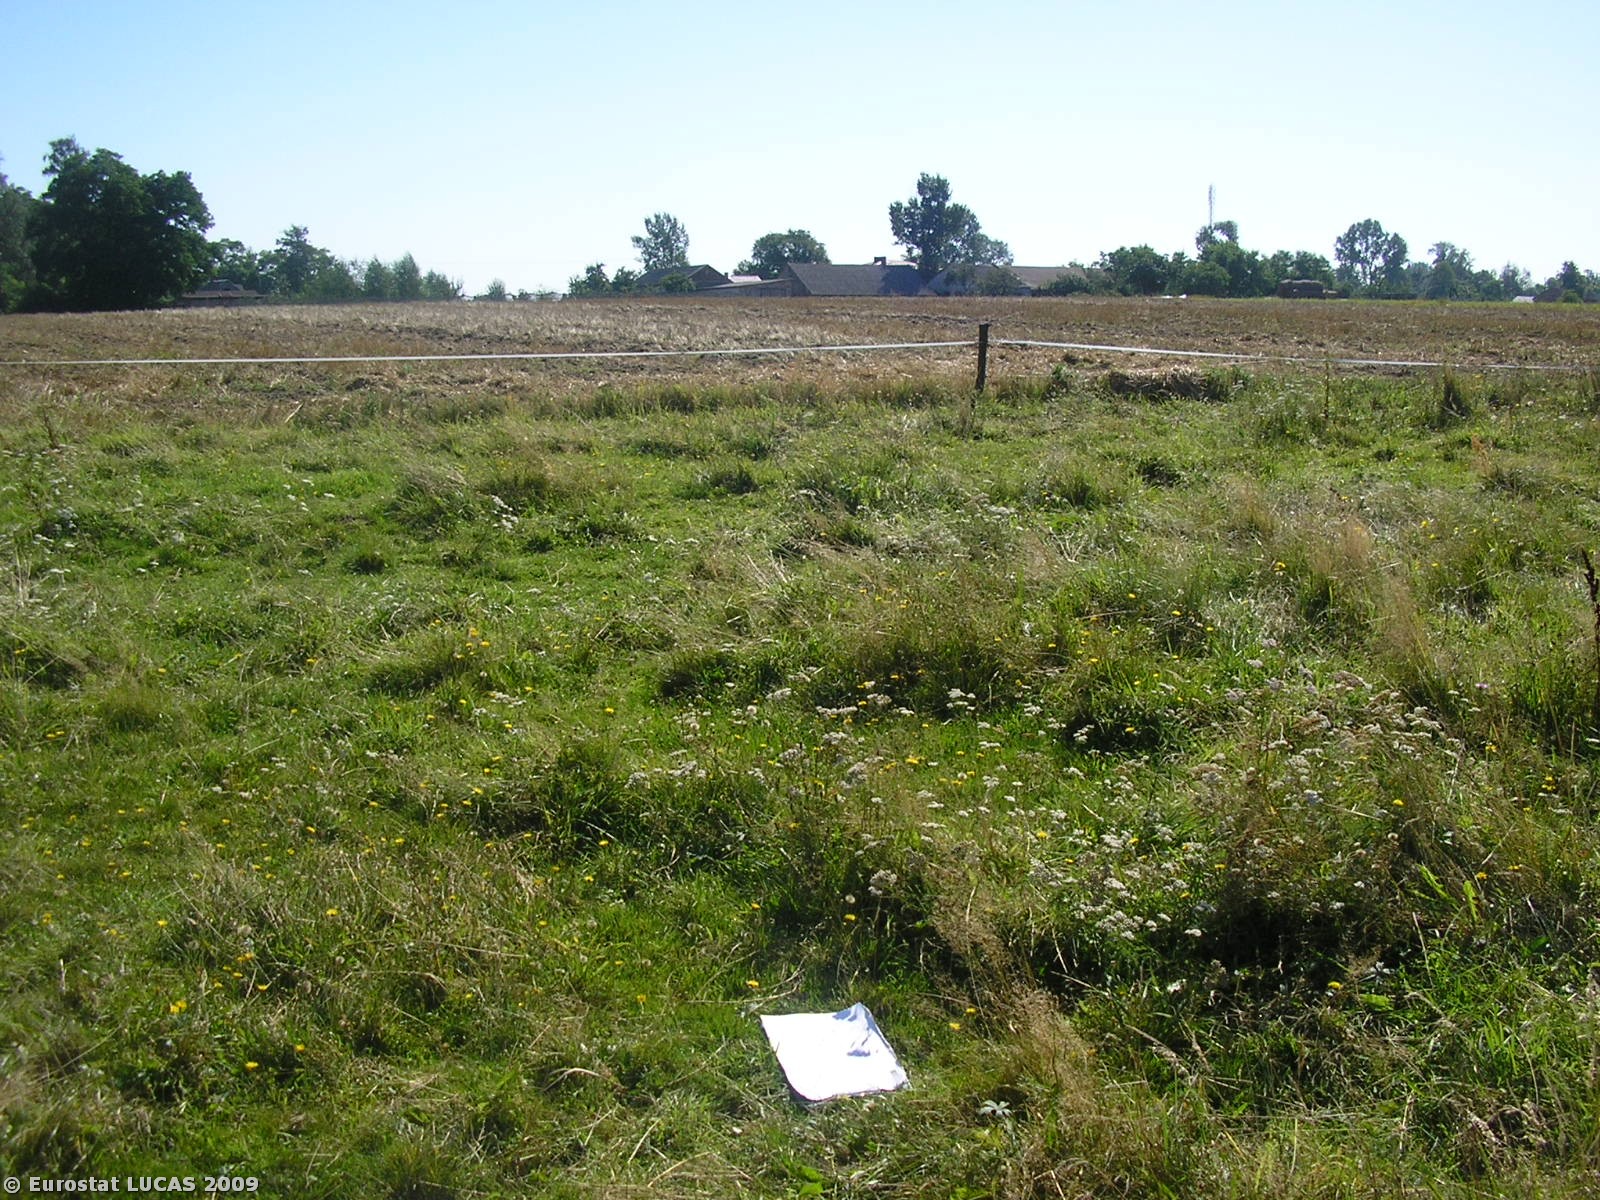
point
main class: Grassland
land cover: Grassland without tree/shrub cover
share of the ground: > 75 %
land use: Agriculture (excluding fallow land and kitchen gardens)
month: September
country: PL
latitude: 51.9725
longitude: 19.5631
